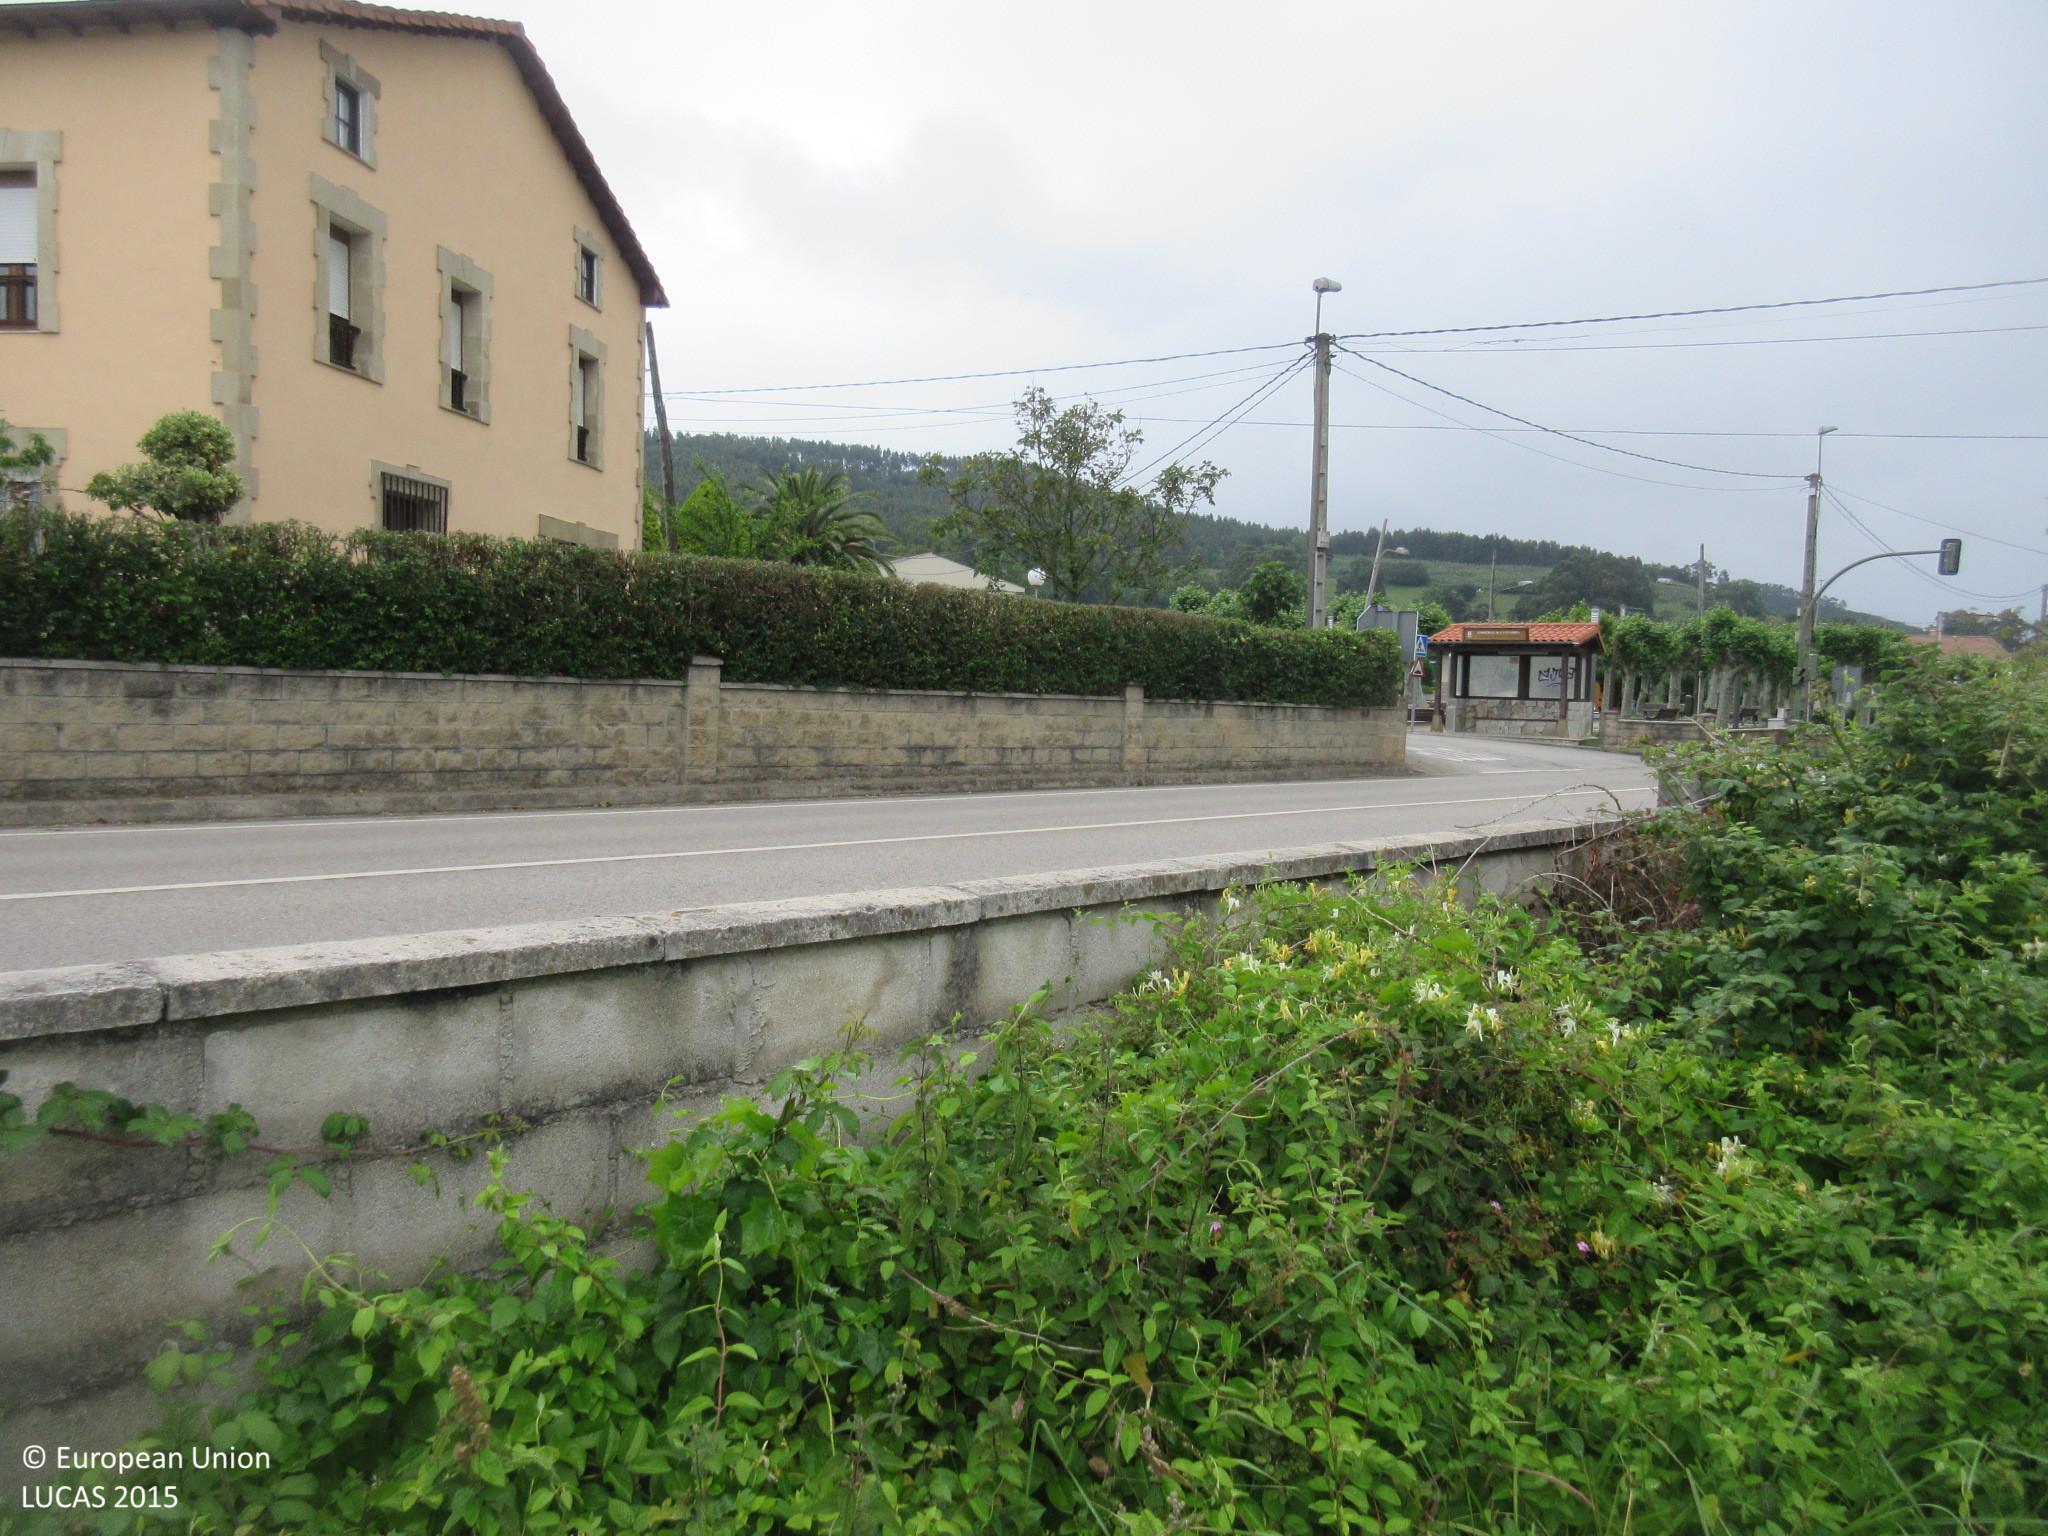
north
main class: Grassland
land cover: Grassland without tree/shrub cover
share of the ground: > 75 %
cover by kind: herbaceous plants 100 %
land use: Agriculture (excluding fallow land and kitchen gardens)
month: June
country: ES
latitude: 43.4567
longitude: -3.5531
